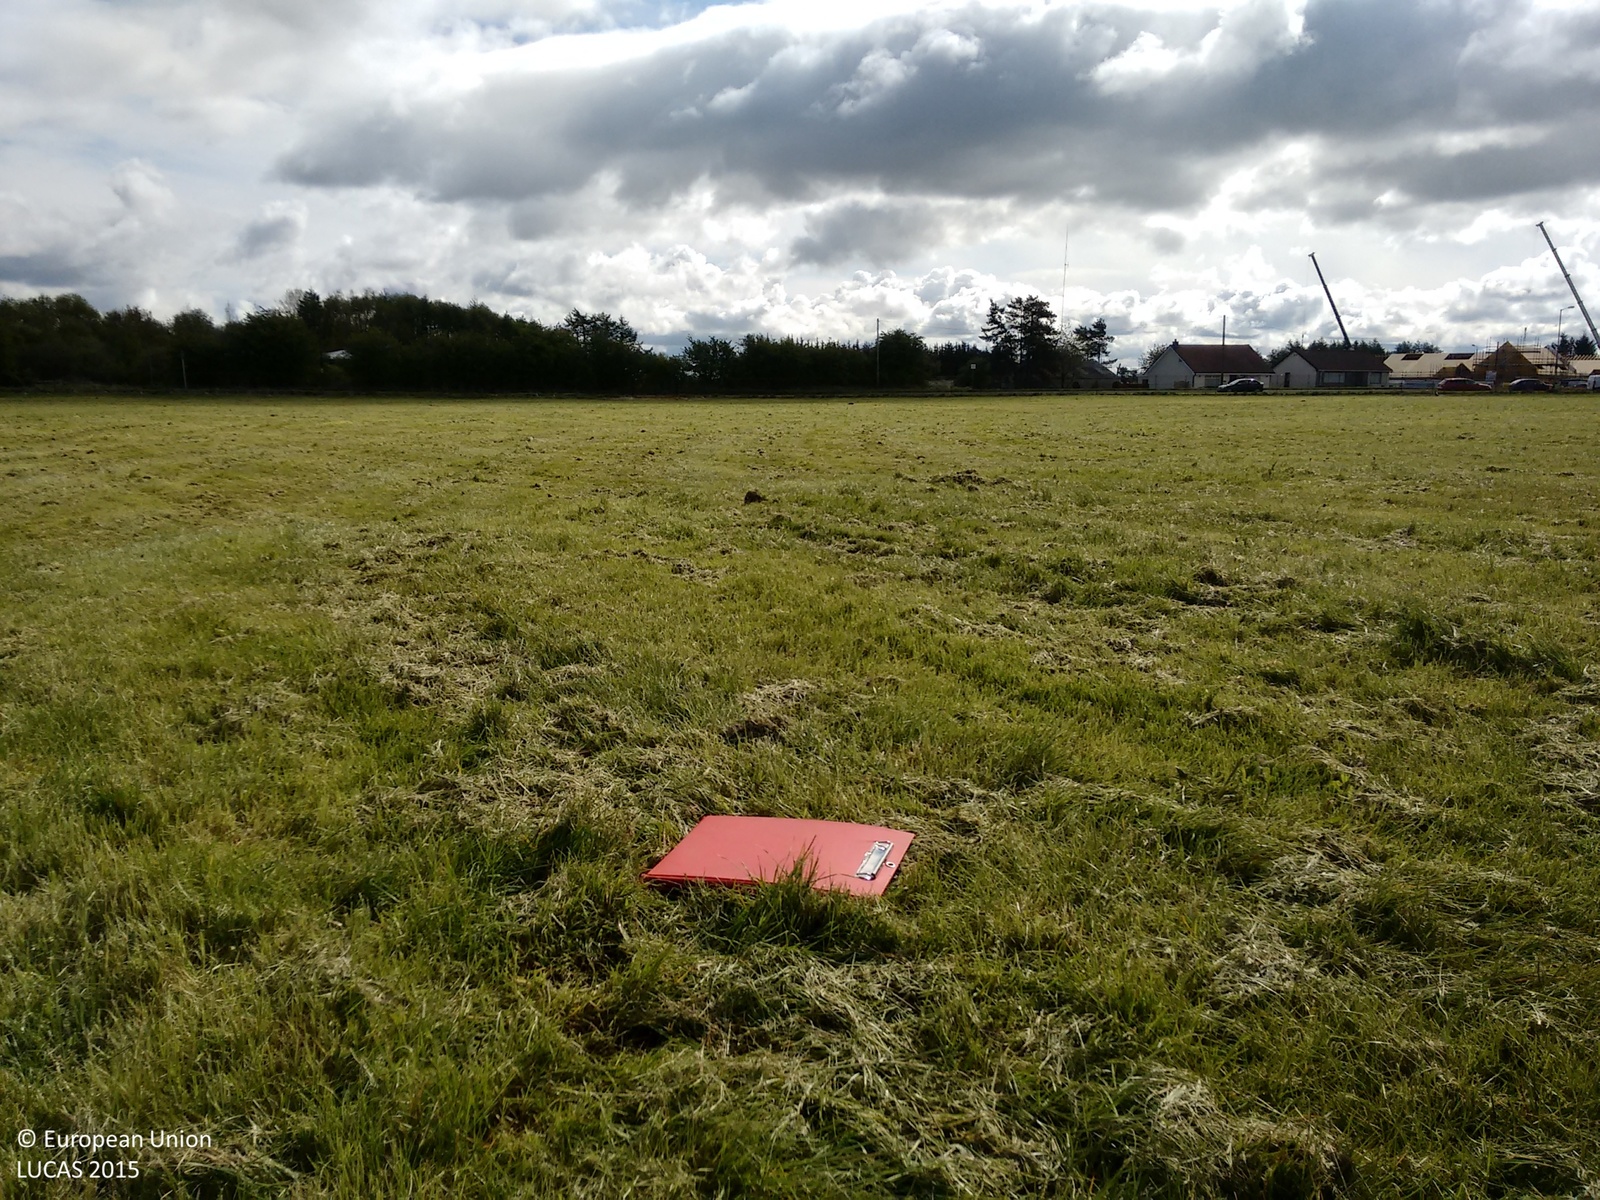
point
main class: Grassland
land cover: Grassland without tree/shrub cover
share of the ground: > 75 %
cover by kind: herbaceous plants 100 %
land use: Sport
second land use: Community services
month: May
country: GB
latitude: 55.8531
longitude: -4.4912
